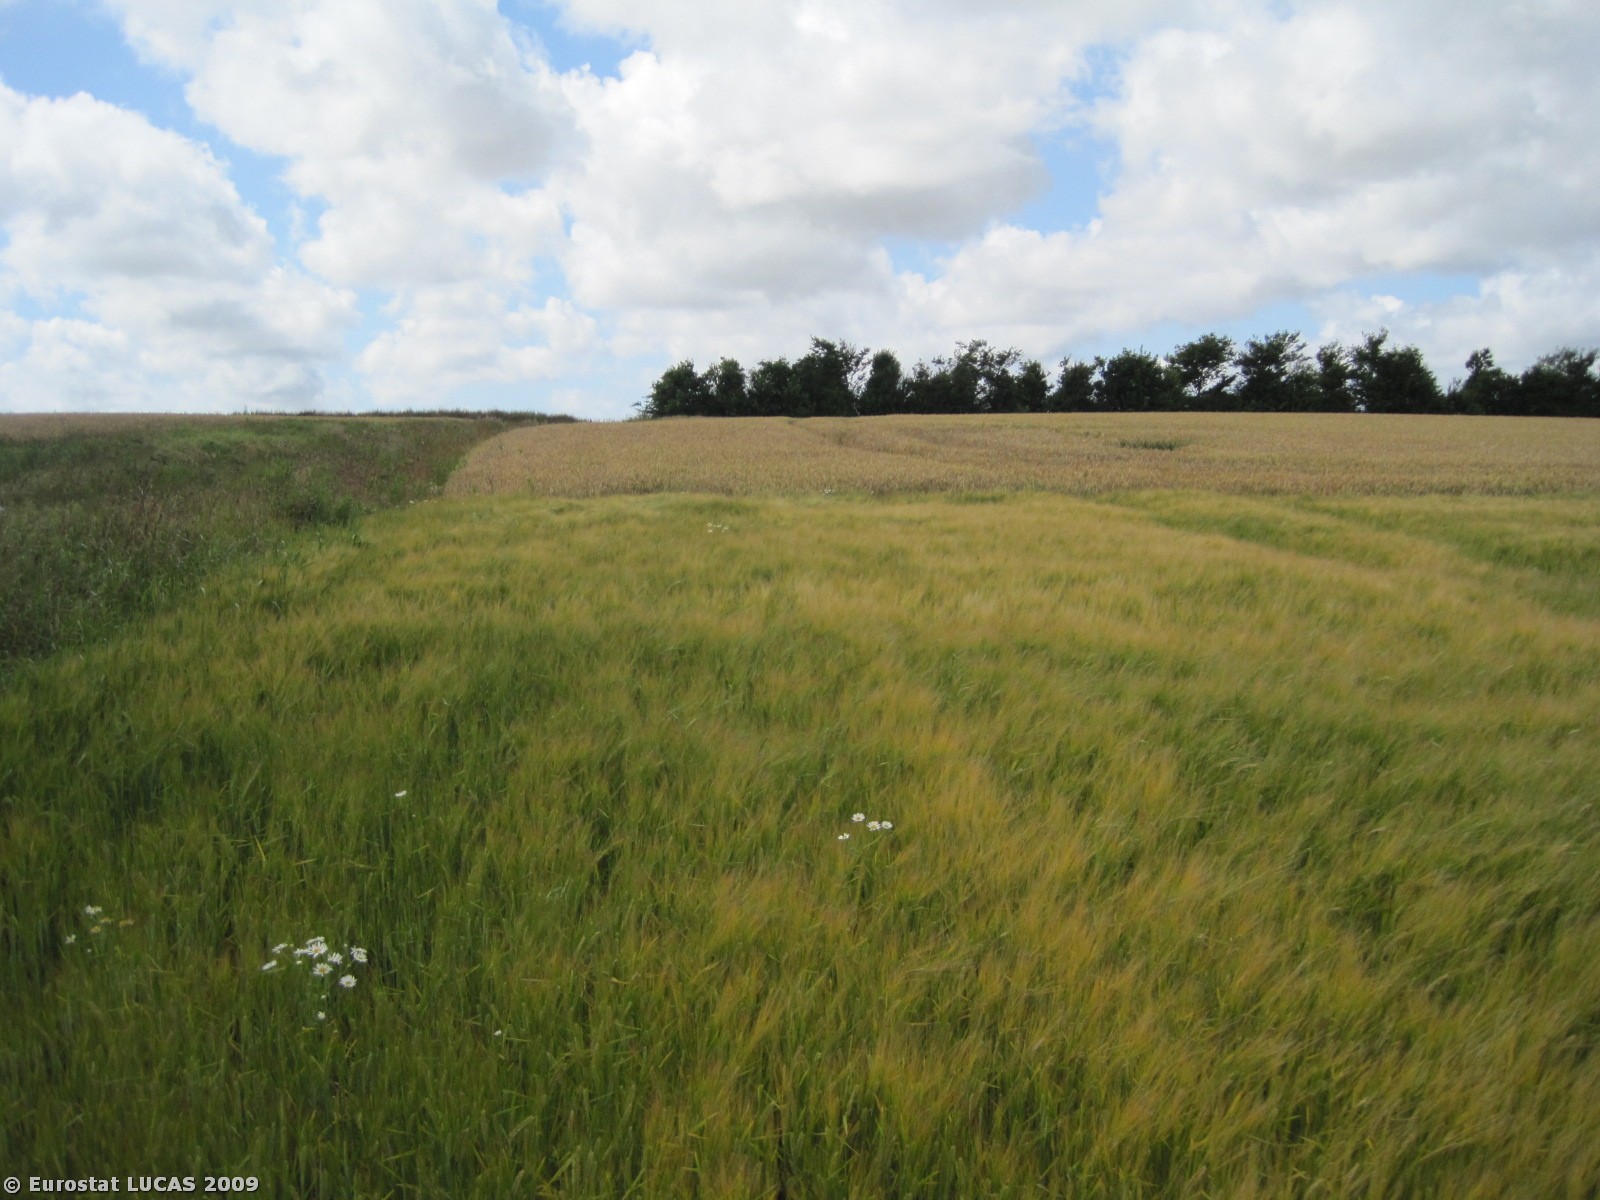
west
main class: Cropland
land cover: Barley
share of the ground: > 75 %
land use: Agriculture (excluding fallow land and kitchen gardens)
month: July
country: DK
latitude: 56.8803
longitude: 8.5088
